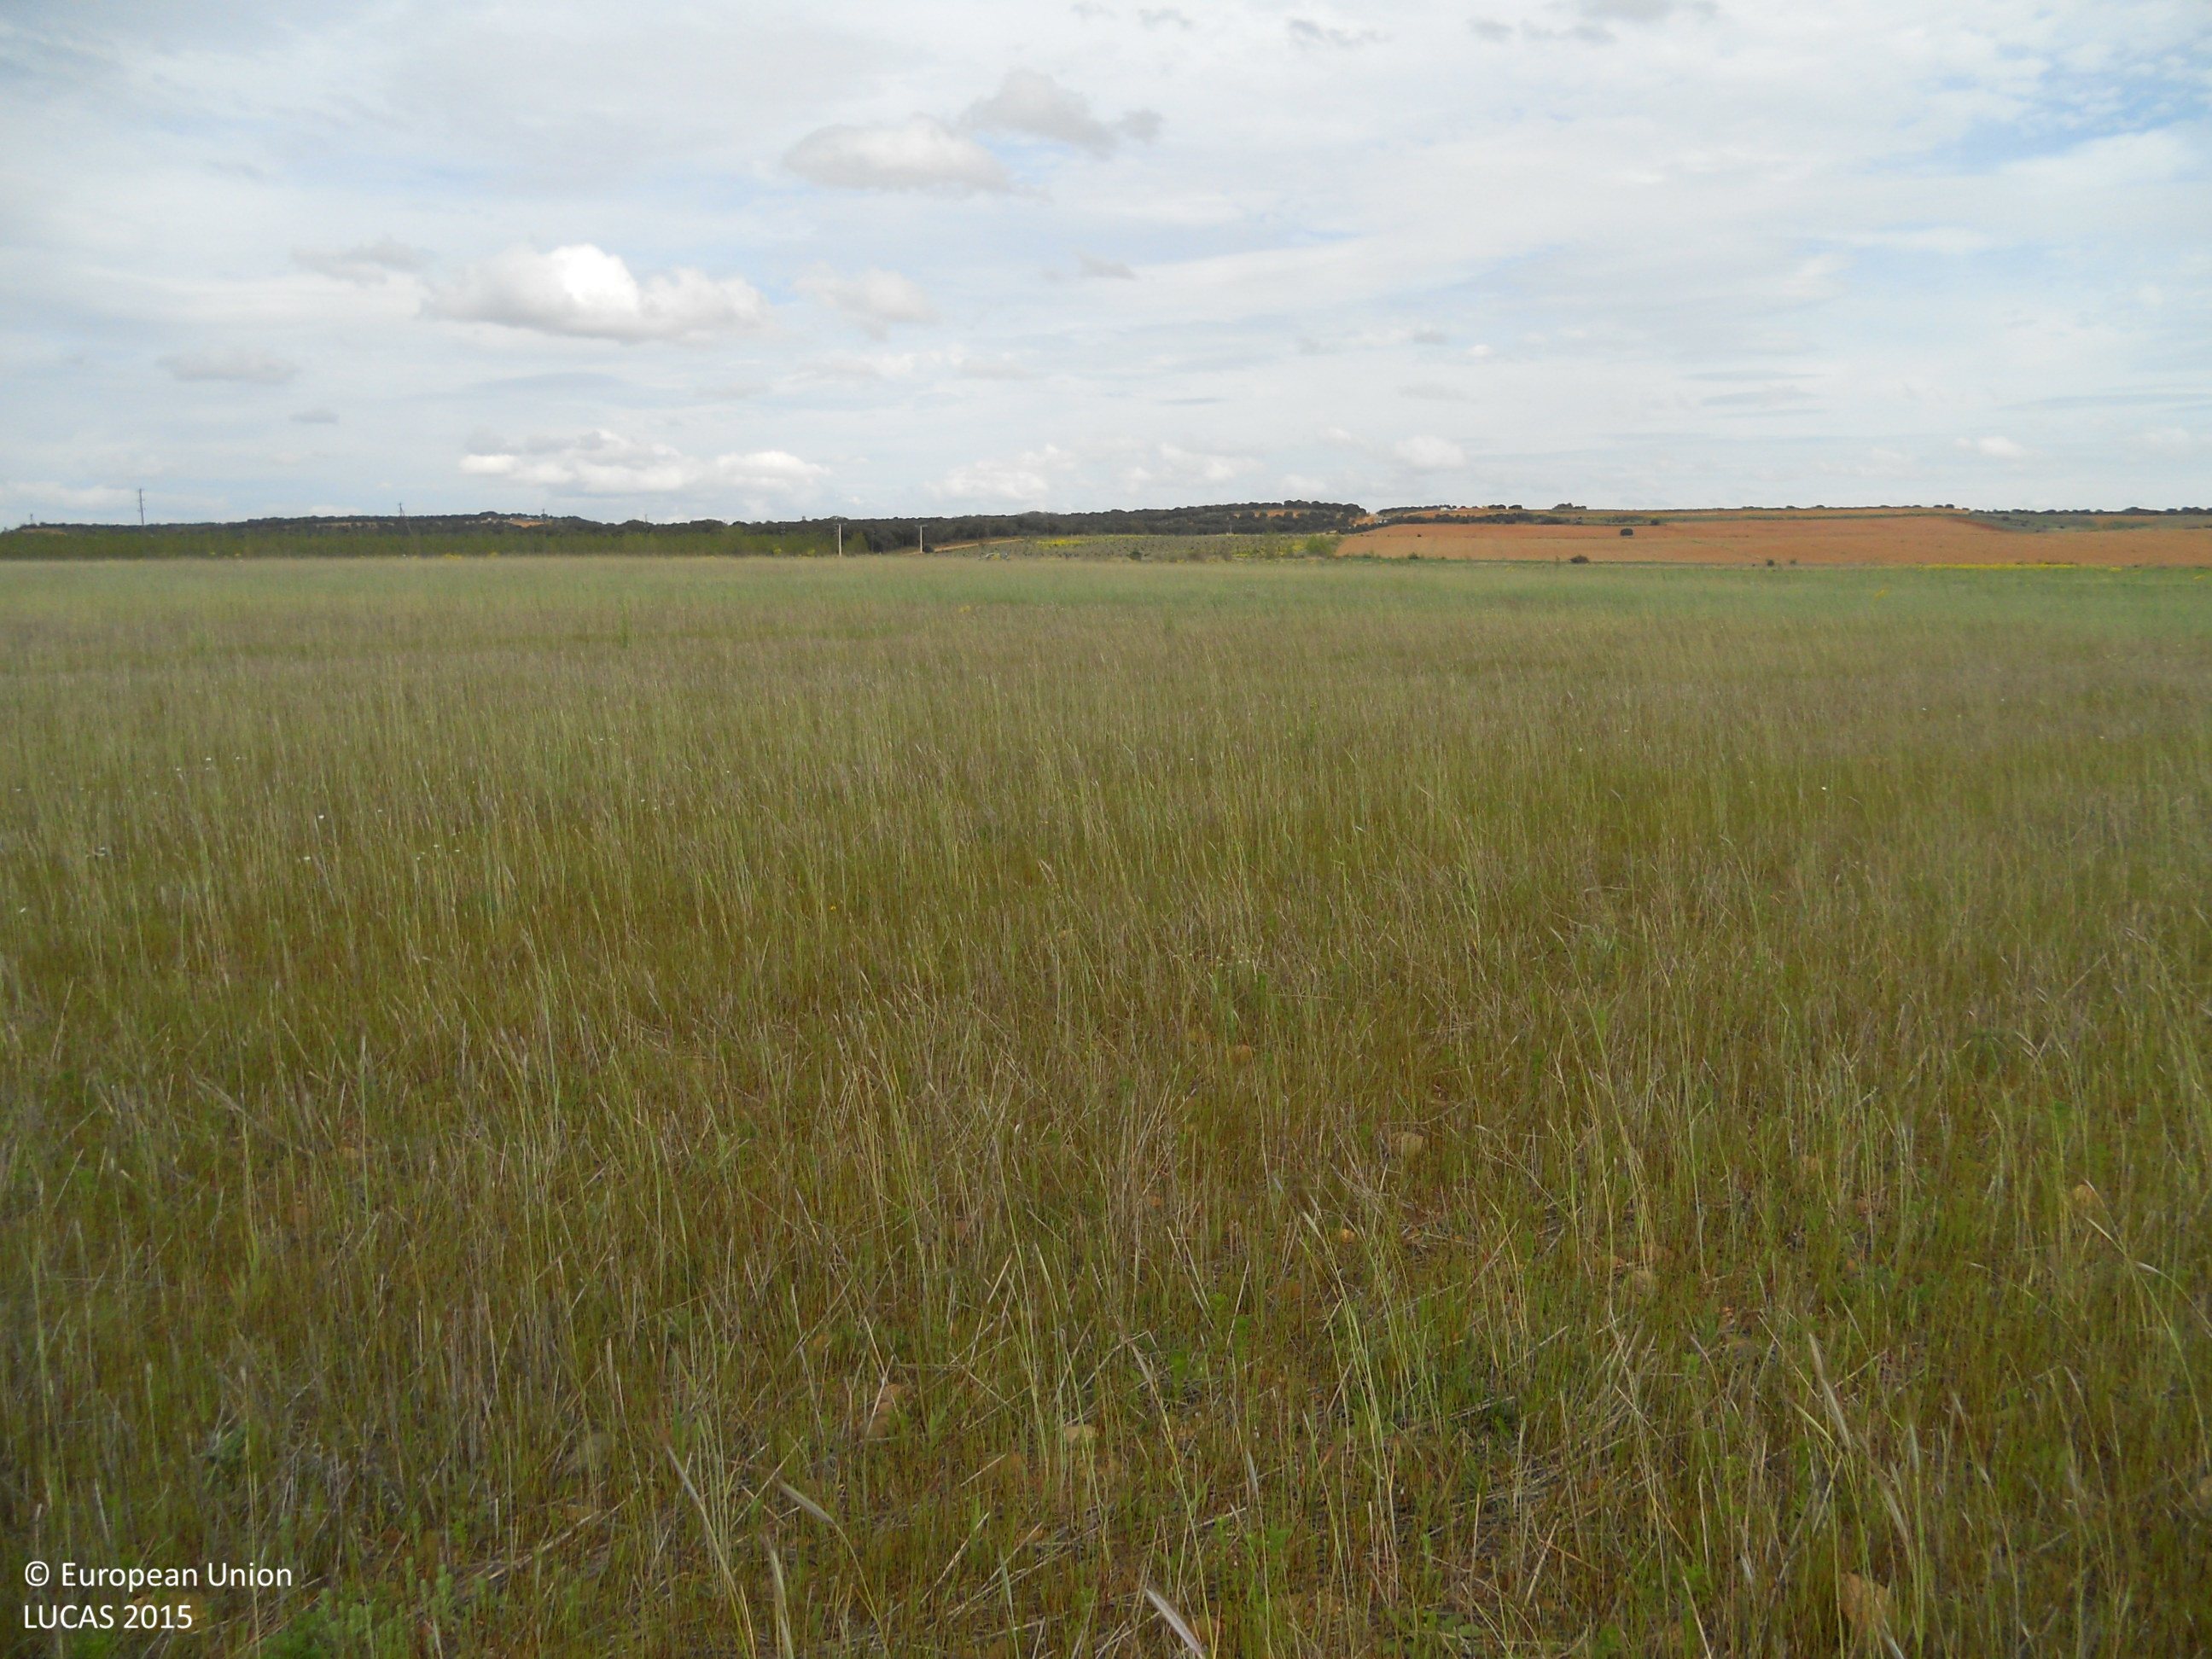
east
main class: Cropland
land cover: Rye
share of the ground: 10 - 25 %
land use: Agriculture (excluding fallow land and kitchen gardens)
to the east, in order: Rye; Spontaneously vegetated surfaces; Rivers and streams; Grass margins; Tracks; Grassland without tree/shrub cover
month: May
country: ES
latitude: 42.5050
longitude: -5.3396
